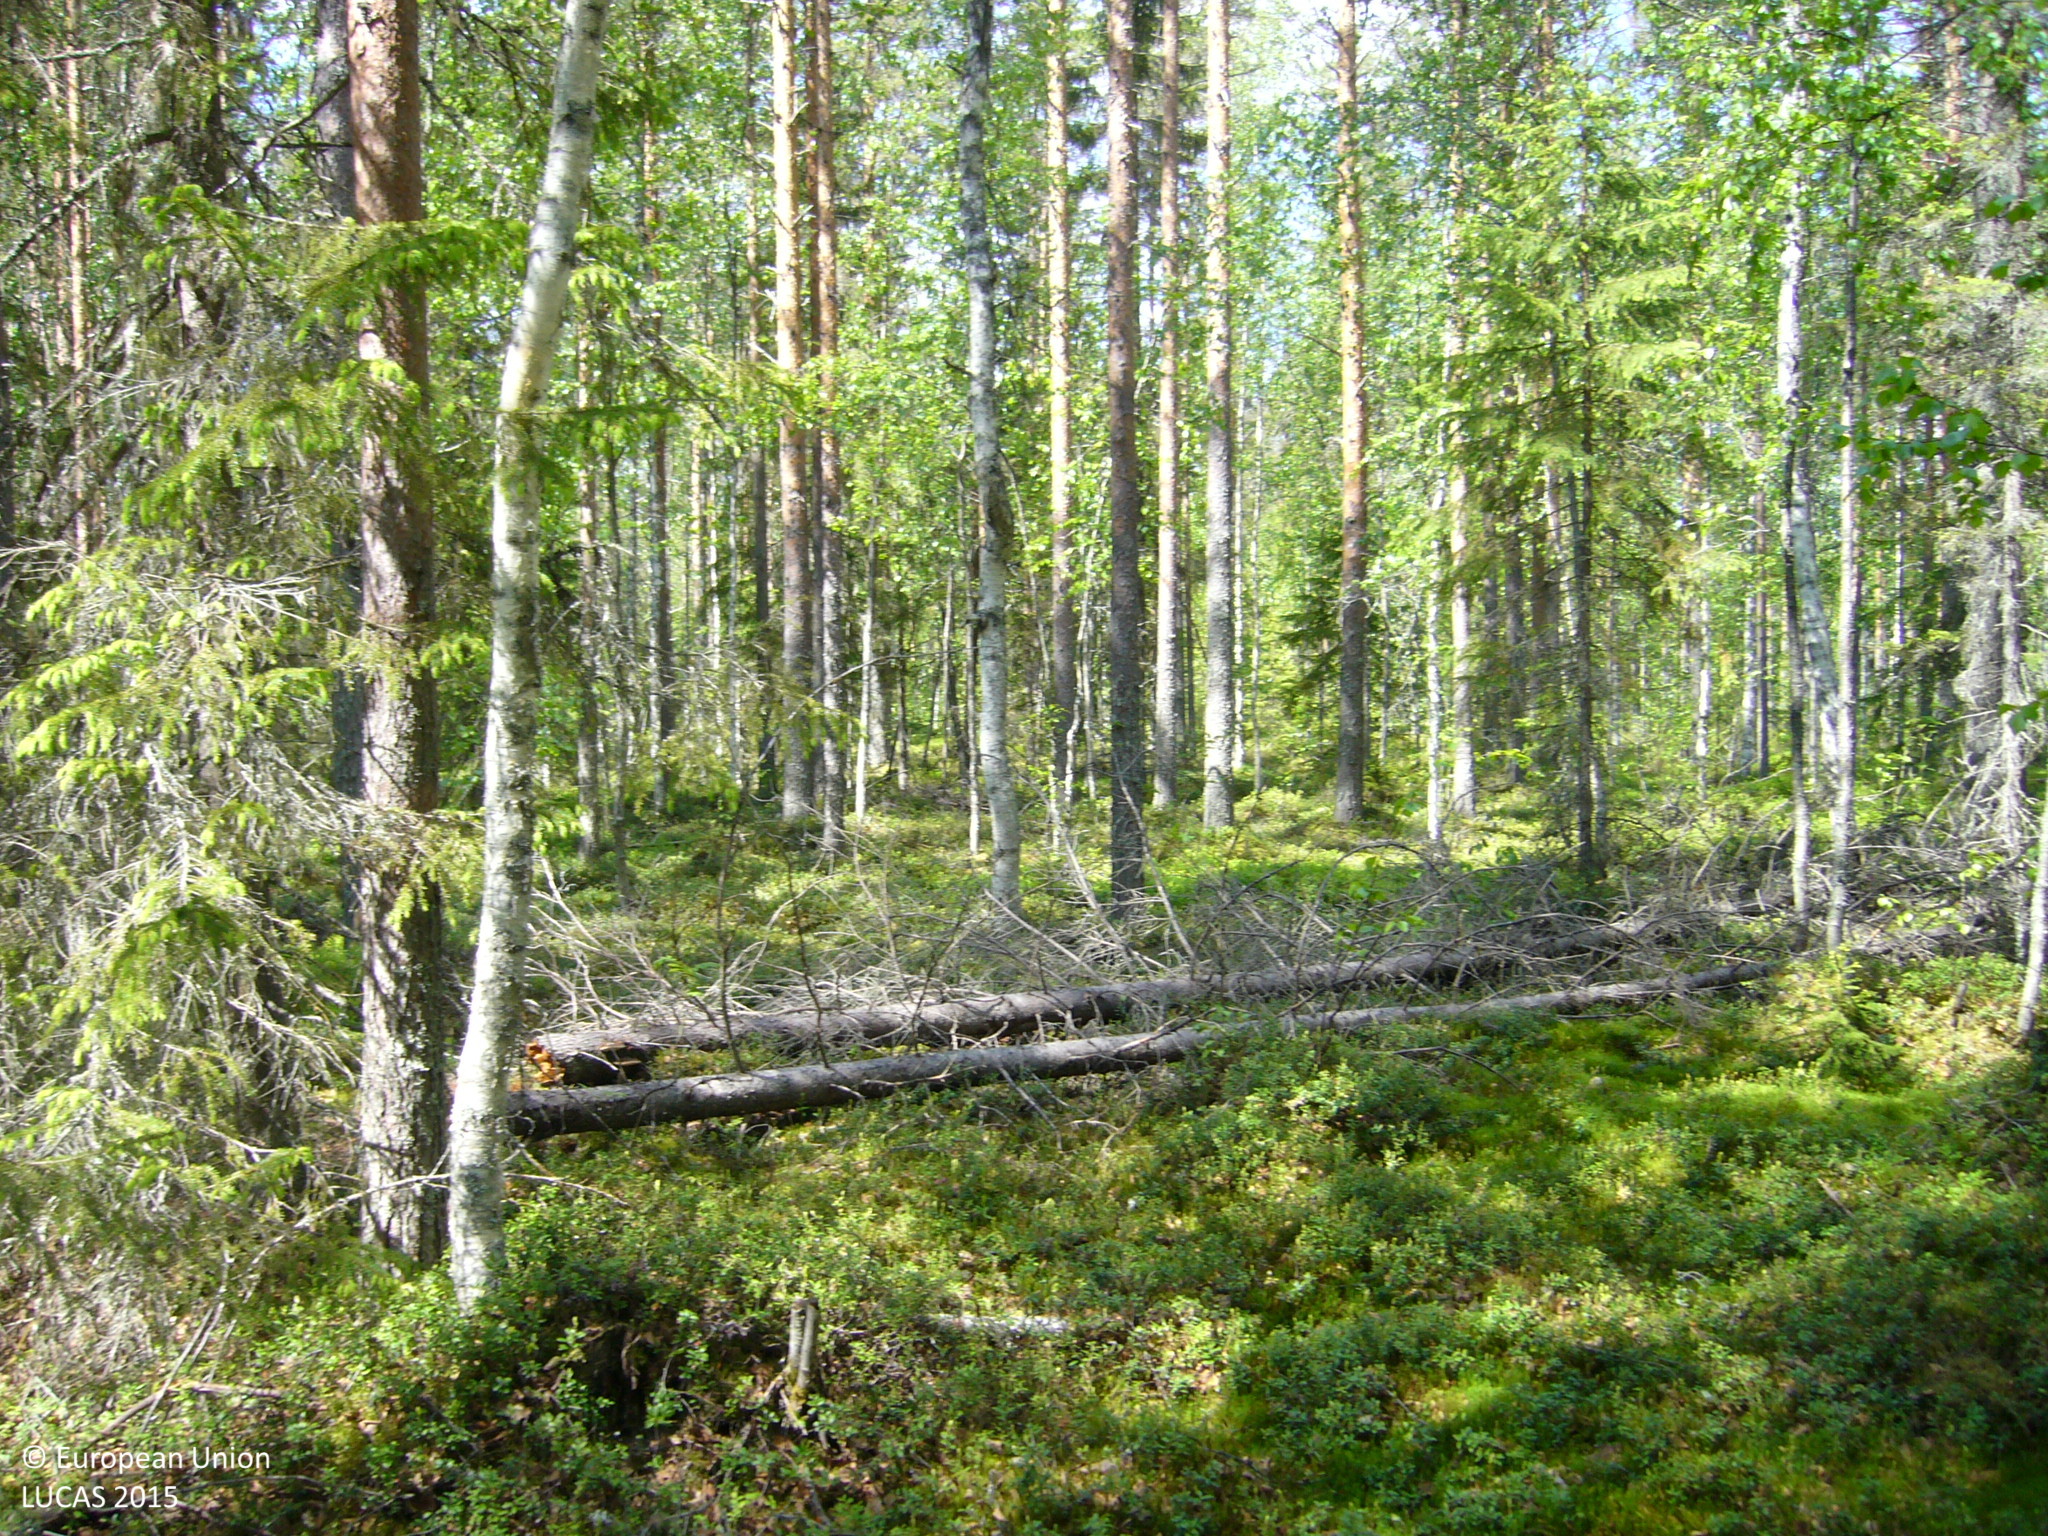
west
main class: Woodland
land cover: Pine dominated mixed woodland
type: boreal forest
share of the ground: > 75 %
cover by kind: coniferous forest trees 50 %, broadleaved forest trees 25 %, shrubs 25 %
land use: Forestry
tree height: > 5 m
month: June
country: FI
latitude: 63.7407
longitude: 25.6817
